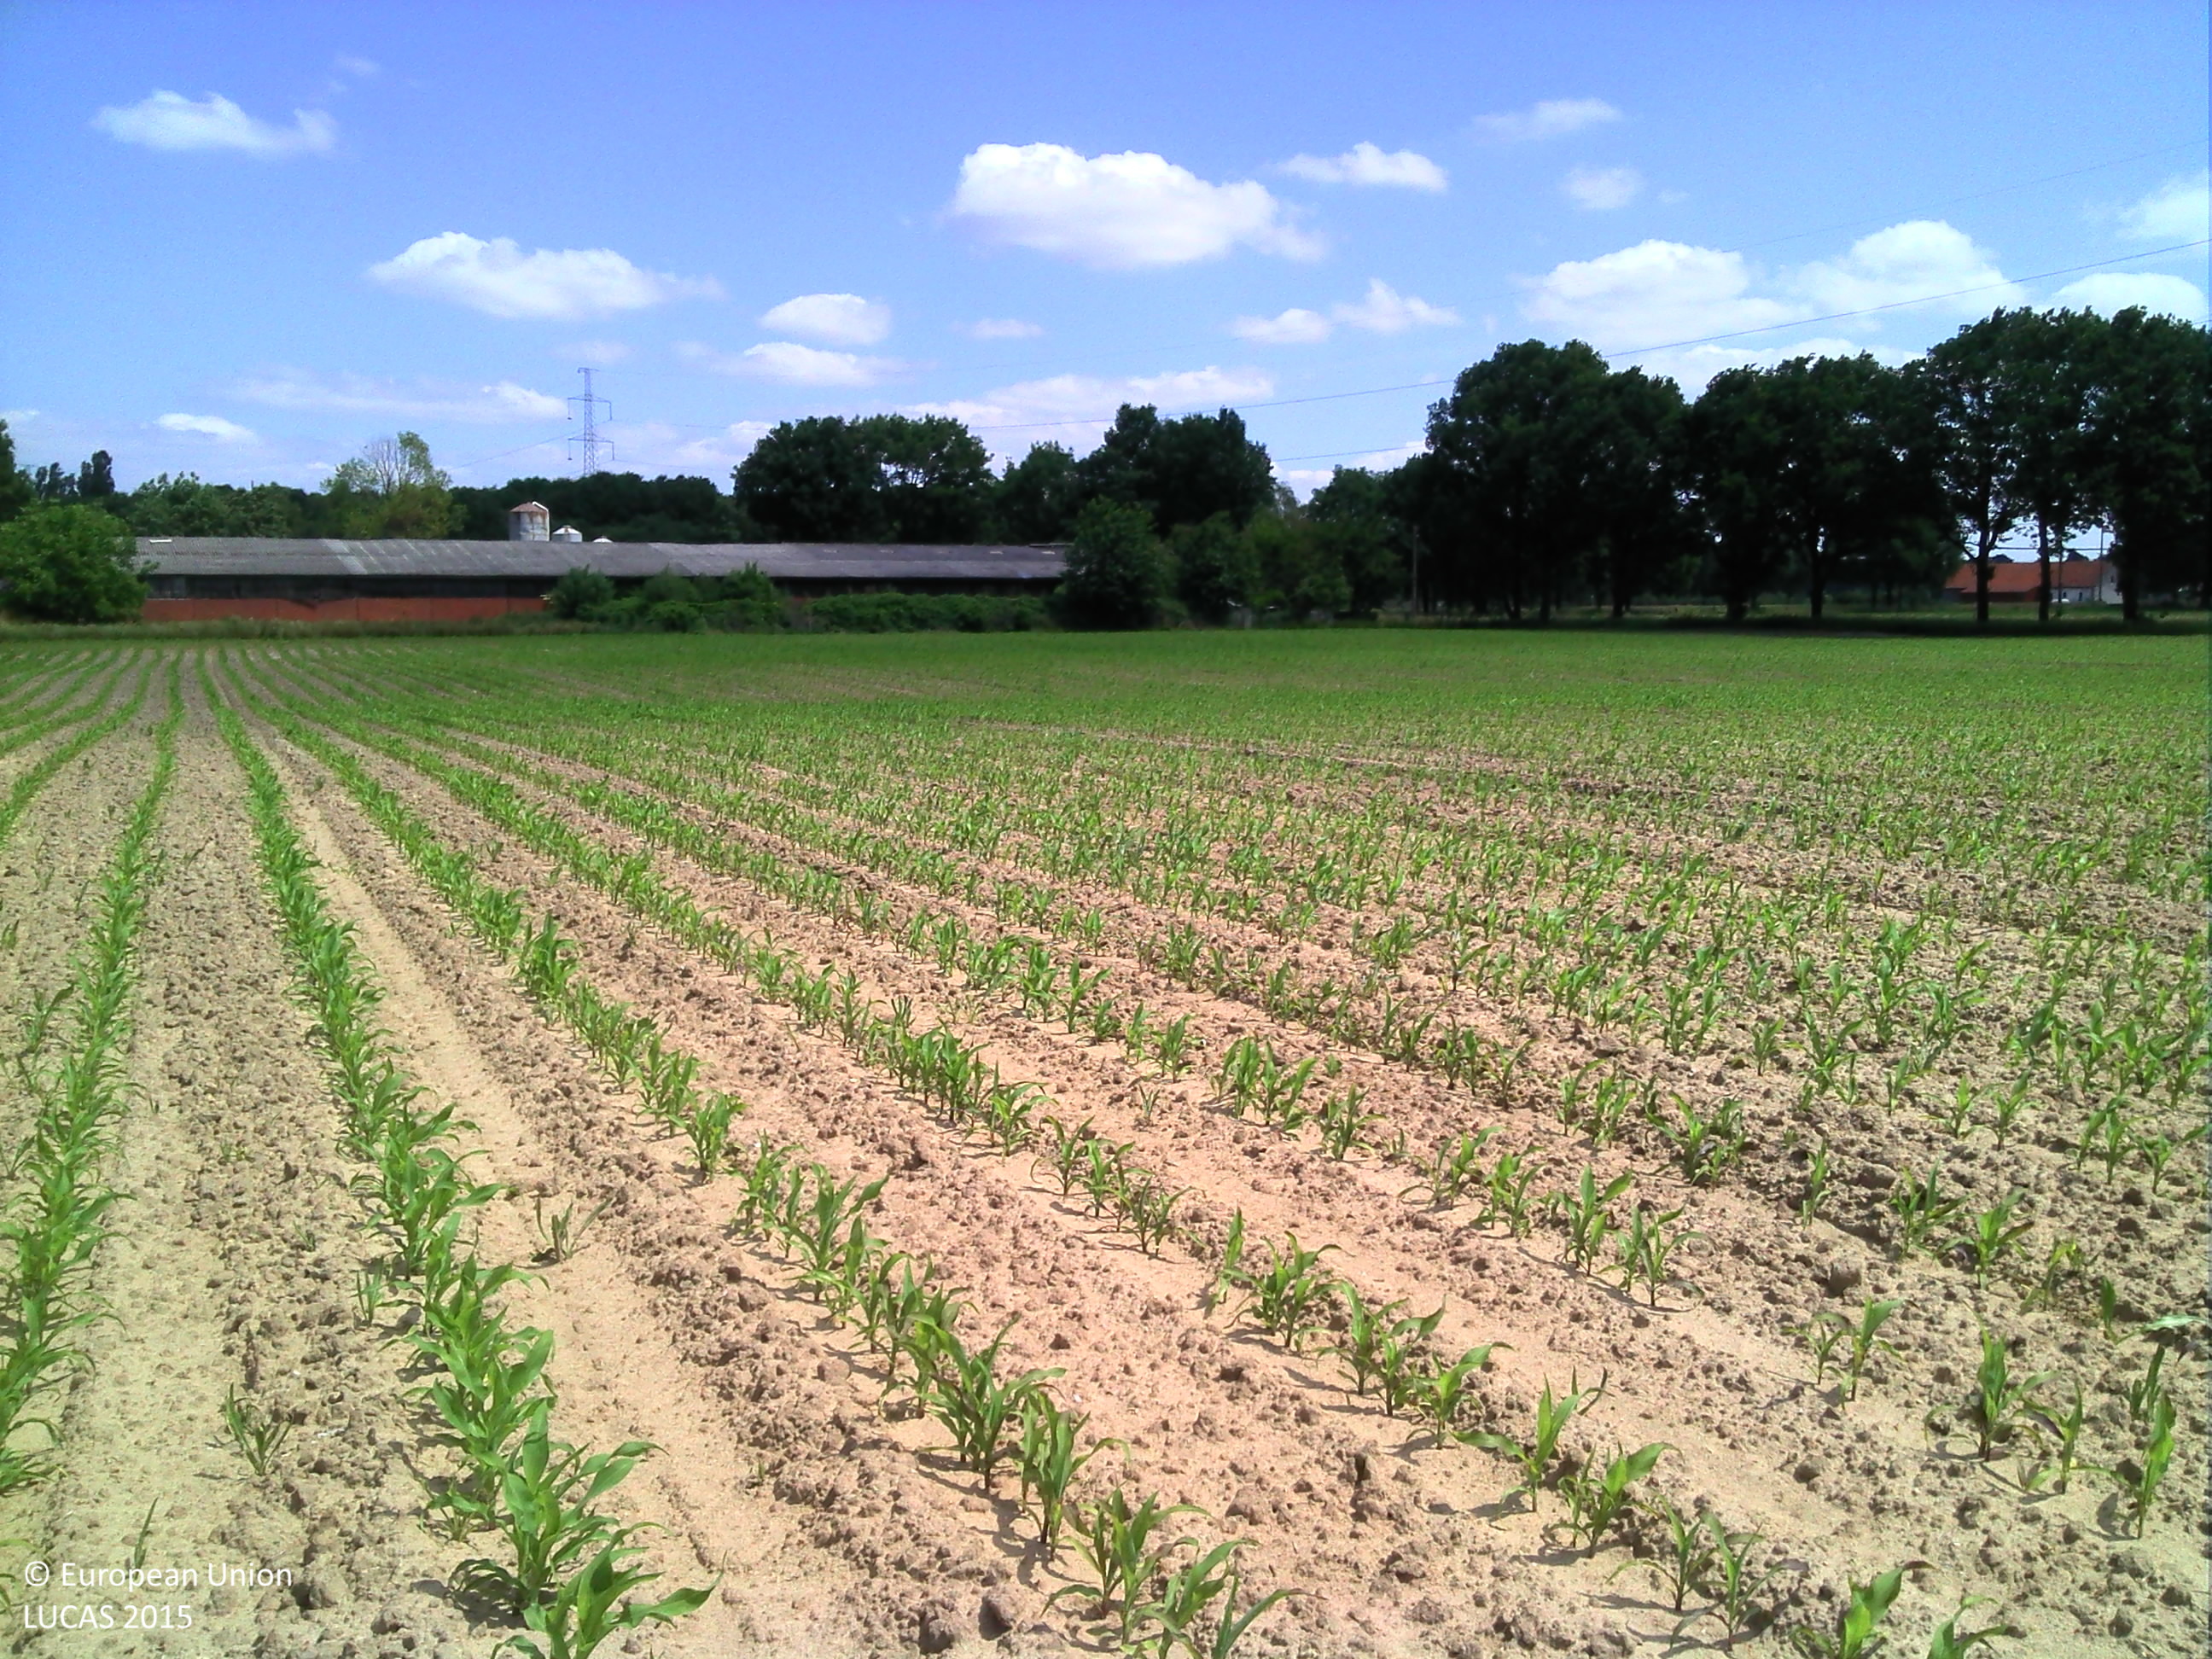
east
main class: Cropland
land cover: Maize
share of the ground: 10 - 25 %
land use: Agriculture (excluding fallow land and kitchen gardens)
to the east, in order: Maize; Artificial constructions in urban areas; Ditches and canals; Tracks; Ditches and canals; Tracks; Lines of trees; Ditches and canals; Grass margins
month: June
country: BE
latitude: 51.1136
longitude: 5.7560
